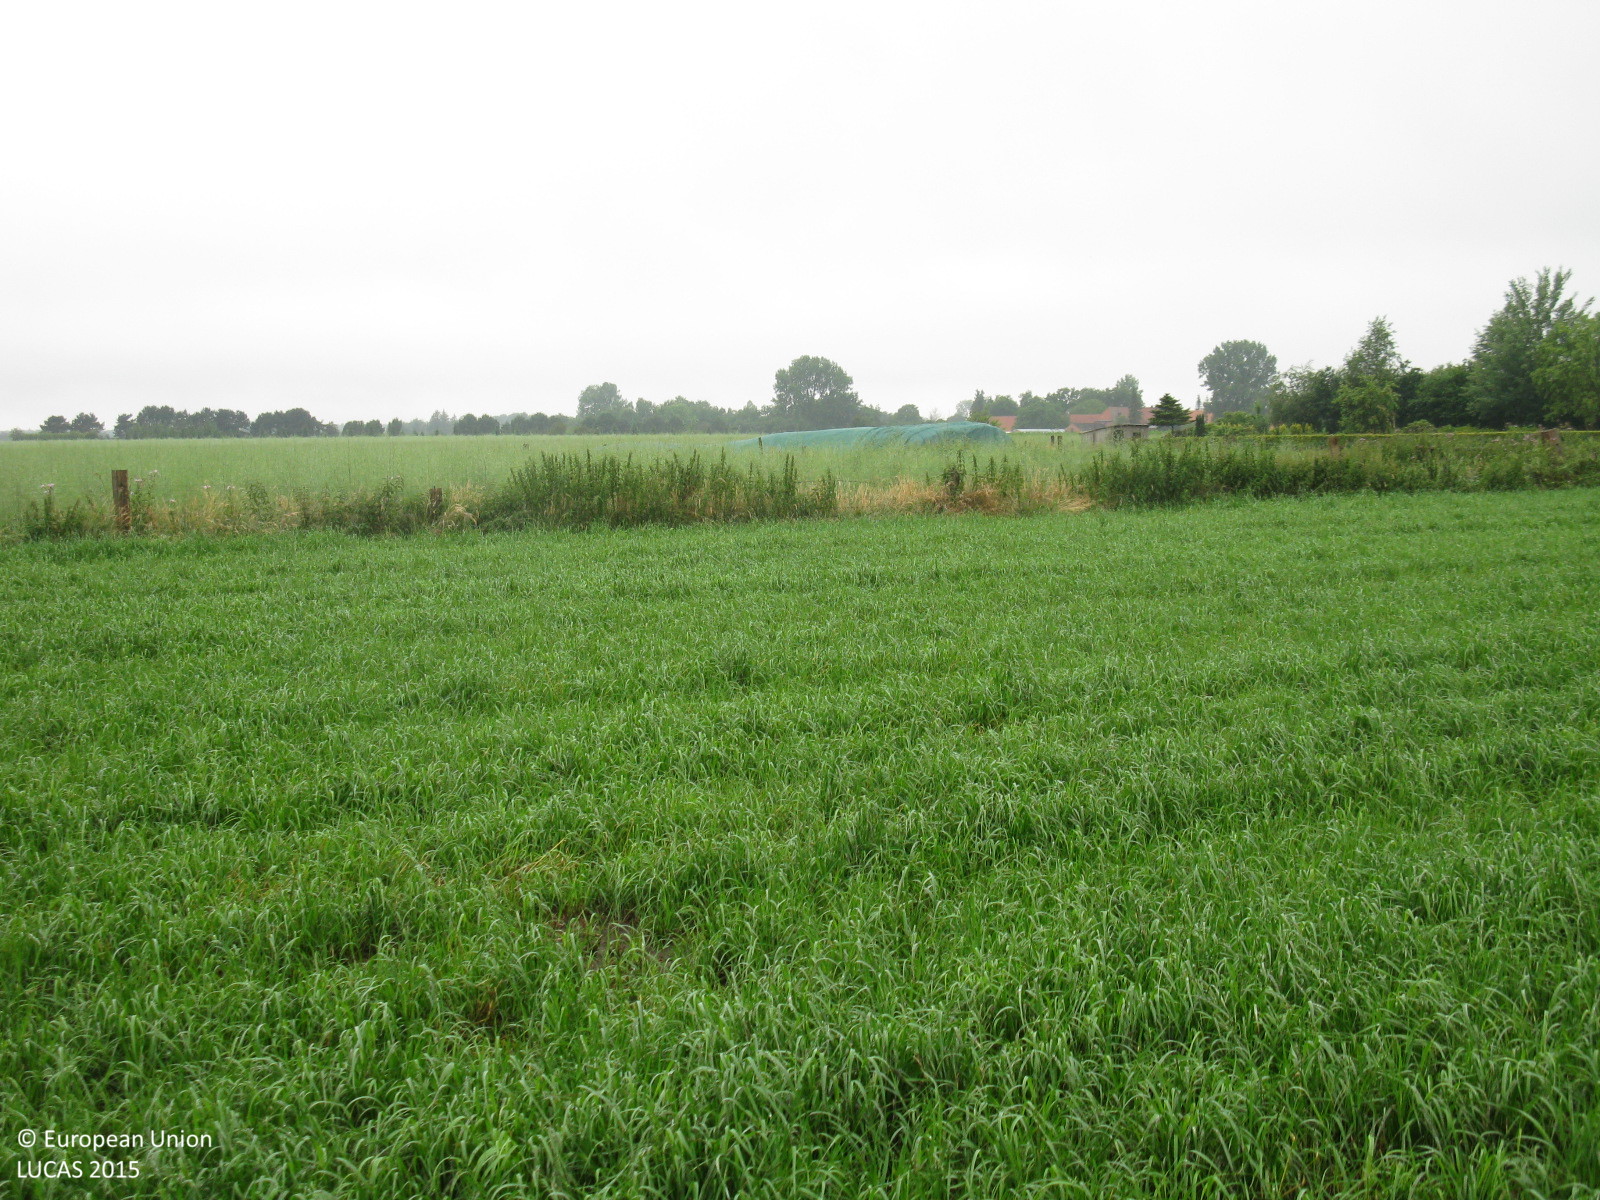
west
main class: Grassland
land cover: Grassland without tree/shrub cover
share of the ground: > 75 %
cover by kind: herbaceous plants 100 %
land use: Agriculture (excluding fallow land and kitchen gardens)
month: July
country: DE
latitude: 53.2772
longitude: 7.9761
